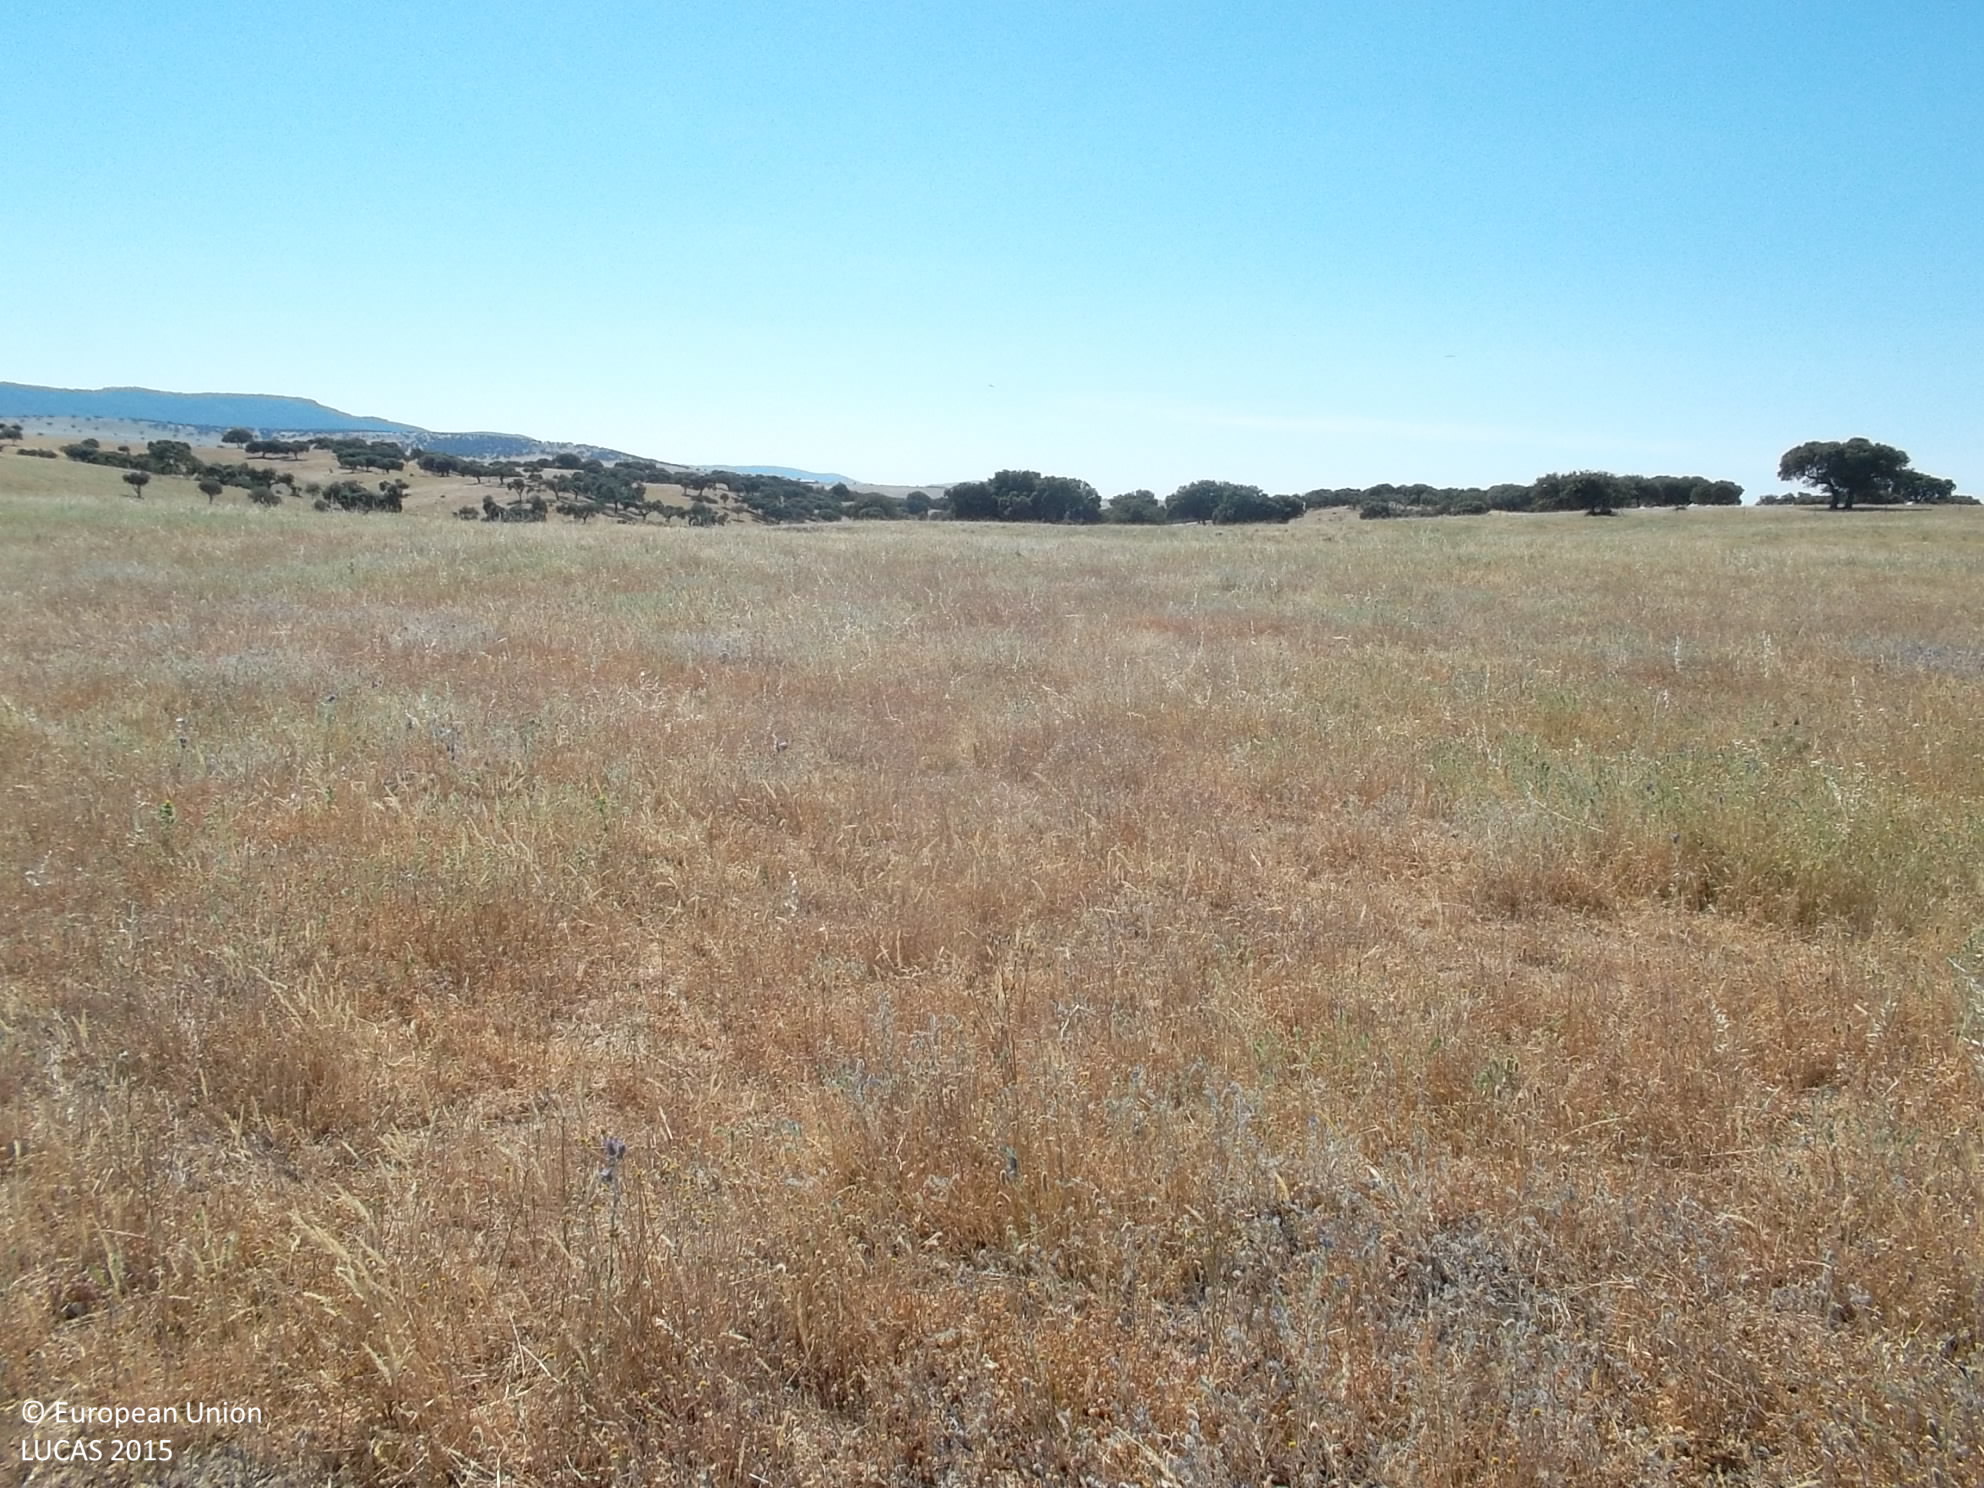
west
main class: Grassland
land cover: Grassland without tree/shrub cover
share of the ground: > 75 %
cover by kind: herbaceous plants 100 %
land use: Agriculture (excluding fallow land and kitchen gardens)
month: May
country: ES
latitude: 38.6099
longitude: -4.4103
